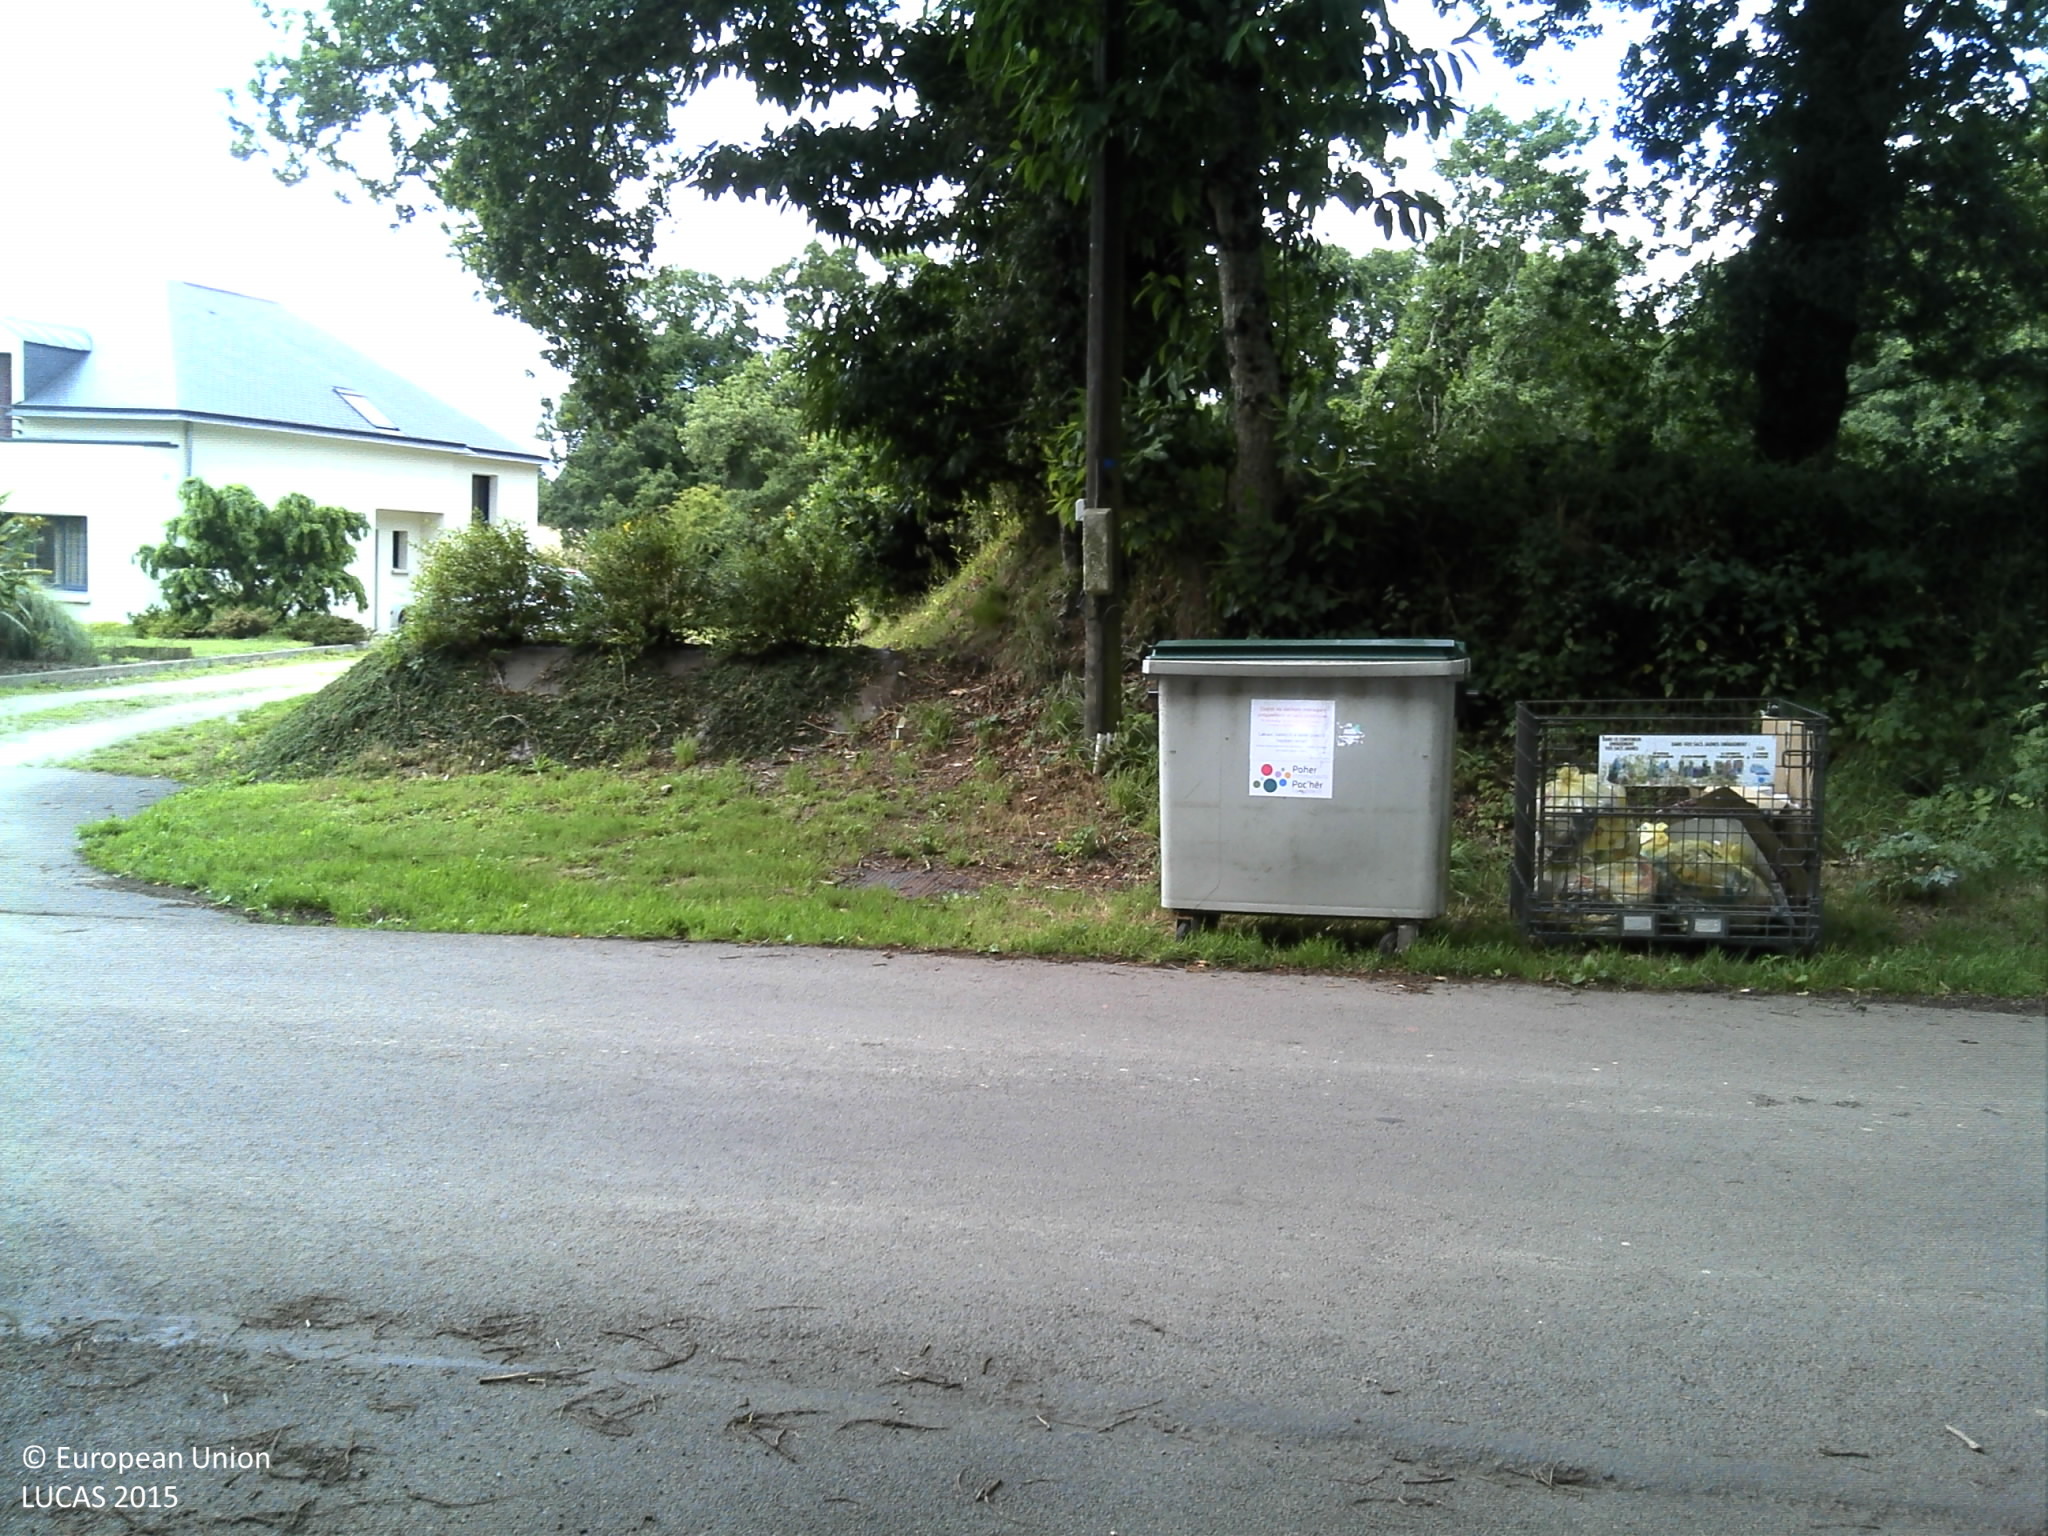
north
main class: Grassland
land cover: Grassland without tree/shrub cover
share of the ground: > 75 %
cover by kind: herbaceous plants 100 %
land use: Residential
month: July
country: FR
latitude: 48.2707
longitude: -3.5932
